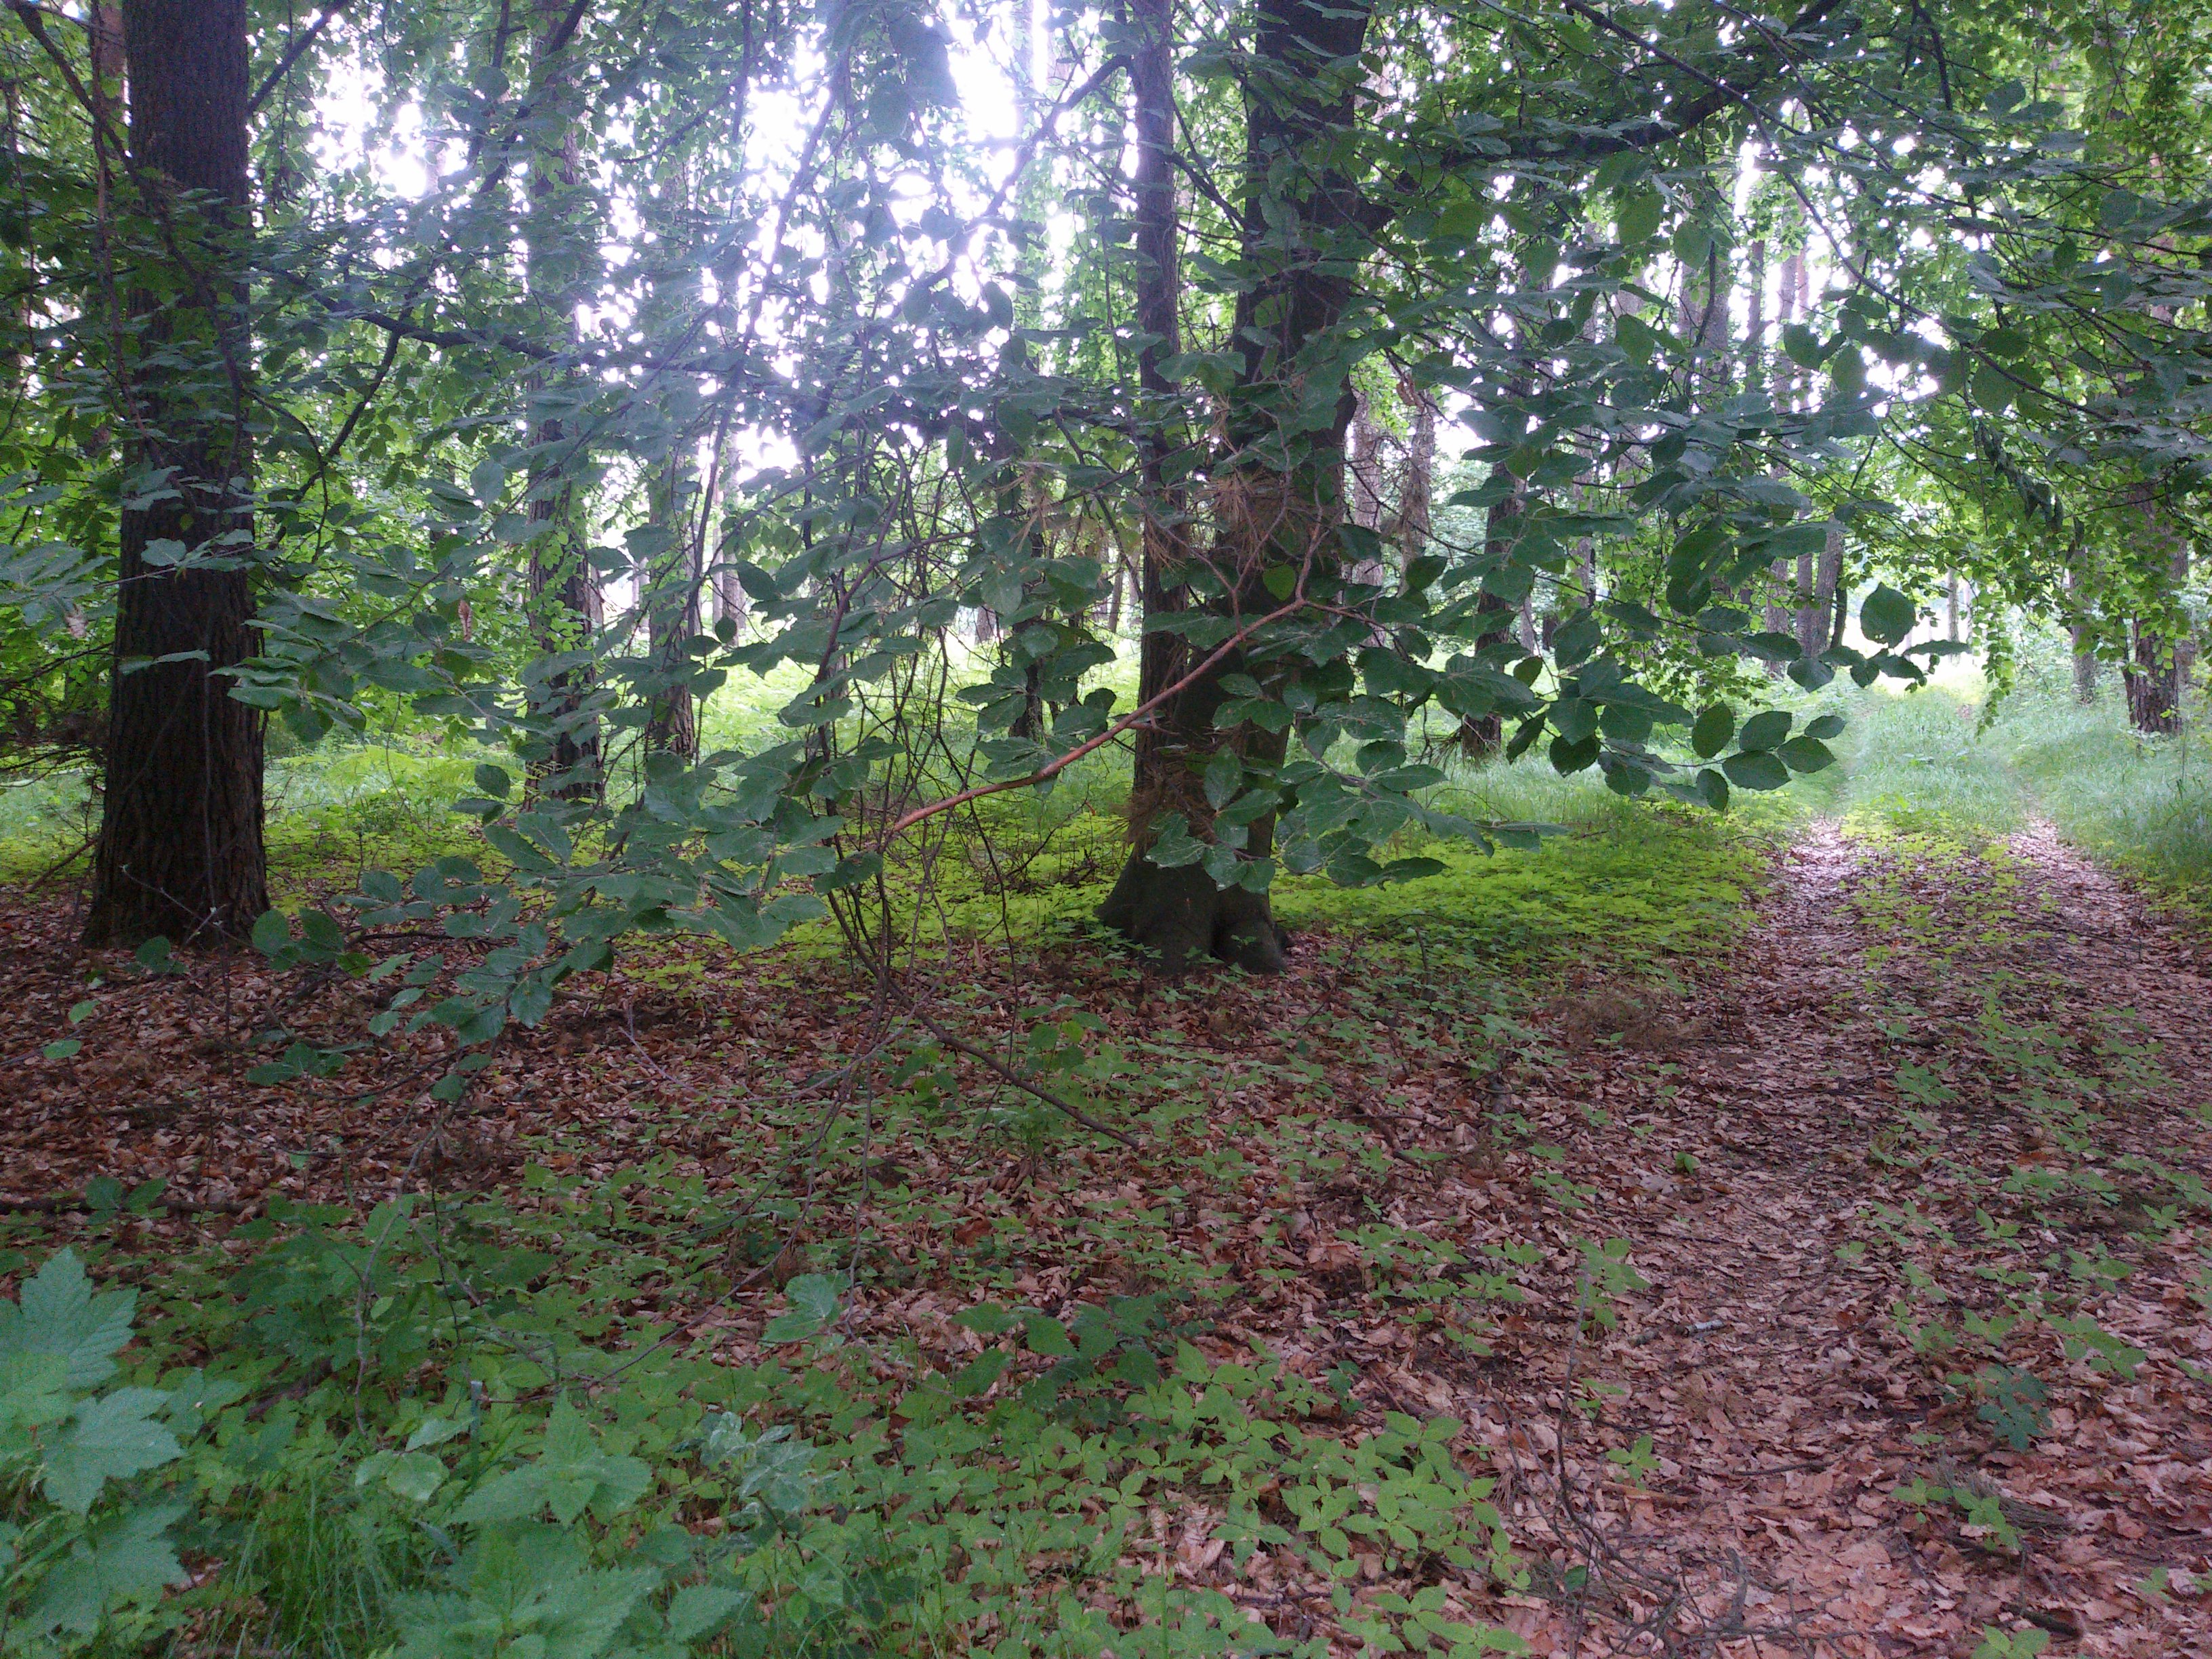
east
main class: Woodland
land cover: Pine dominated mixed woodland
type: hemiboreal forest and nemoral coniferous forest and mixed broadleaved-coniferous forest
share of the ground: > 75 %
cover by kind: coniferous forest trees 60 %, broadleaved forest trees 25 %, herbaceous plants 15 %
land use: Forestry
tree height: > 5 m
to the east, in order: Pine dominated mixed woodland; Spontaneously vegetated surfaces; Other mixed woodland; Pine dominated mixed woodland; Other mixed woodland
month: May
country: PL
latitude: 50.6664
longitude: 17.6679
